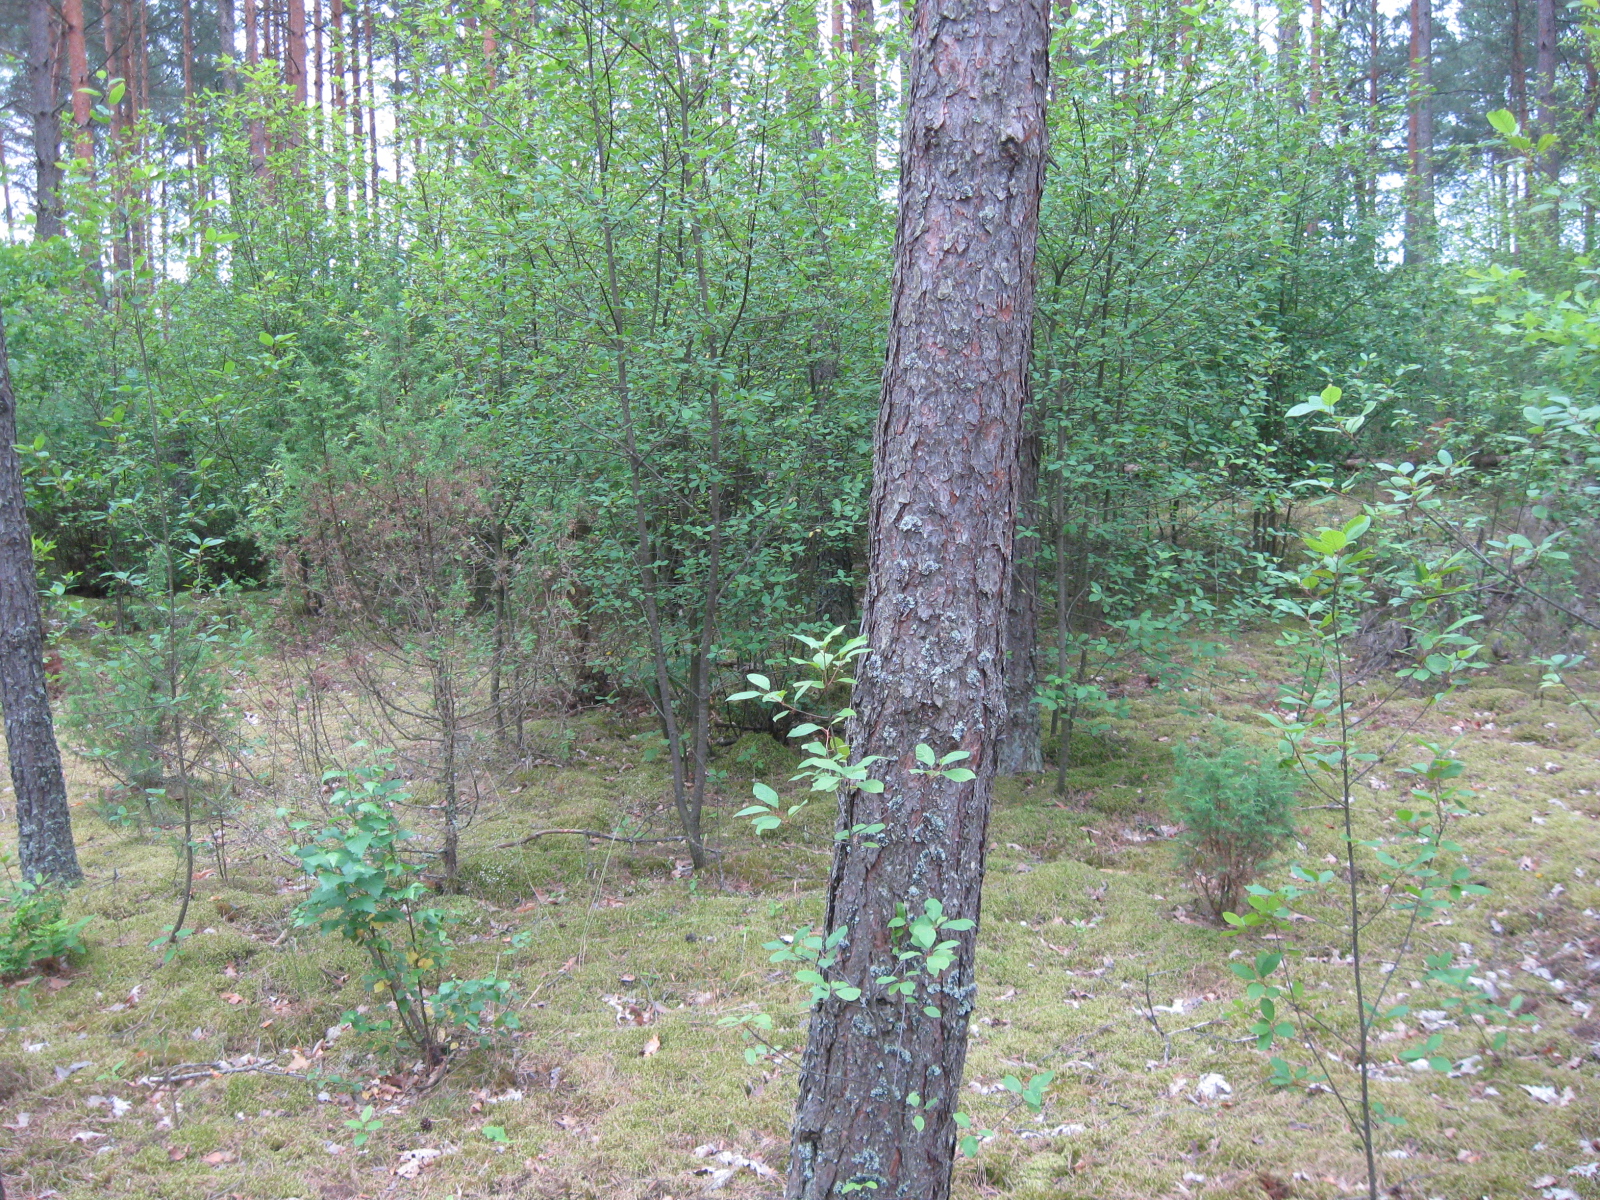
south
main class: Woodland
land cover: Pine dominated mixed woodland
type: hemiboreal forest and nemoral coniferous forest and mixed broadleaved-coniferous forest
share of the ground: > 75 %
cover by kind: coniferous forest trees 50 %, broadleaved forest trees 30 %, lichens and mosses 20 %
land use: Forestry
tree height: > 5 m
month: July
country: LT
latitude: 54.1037
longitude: 24.2761
